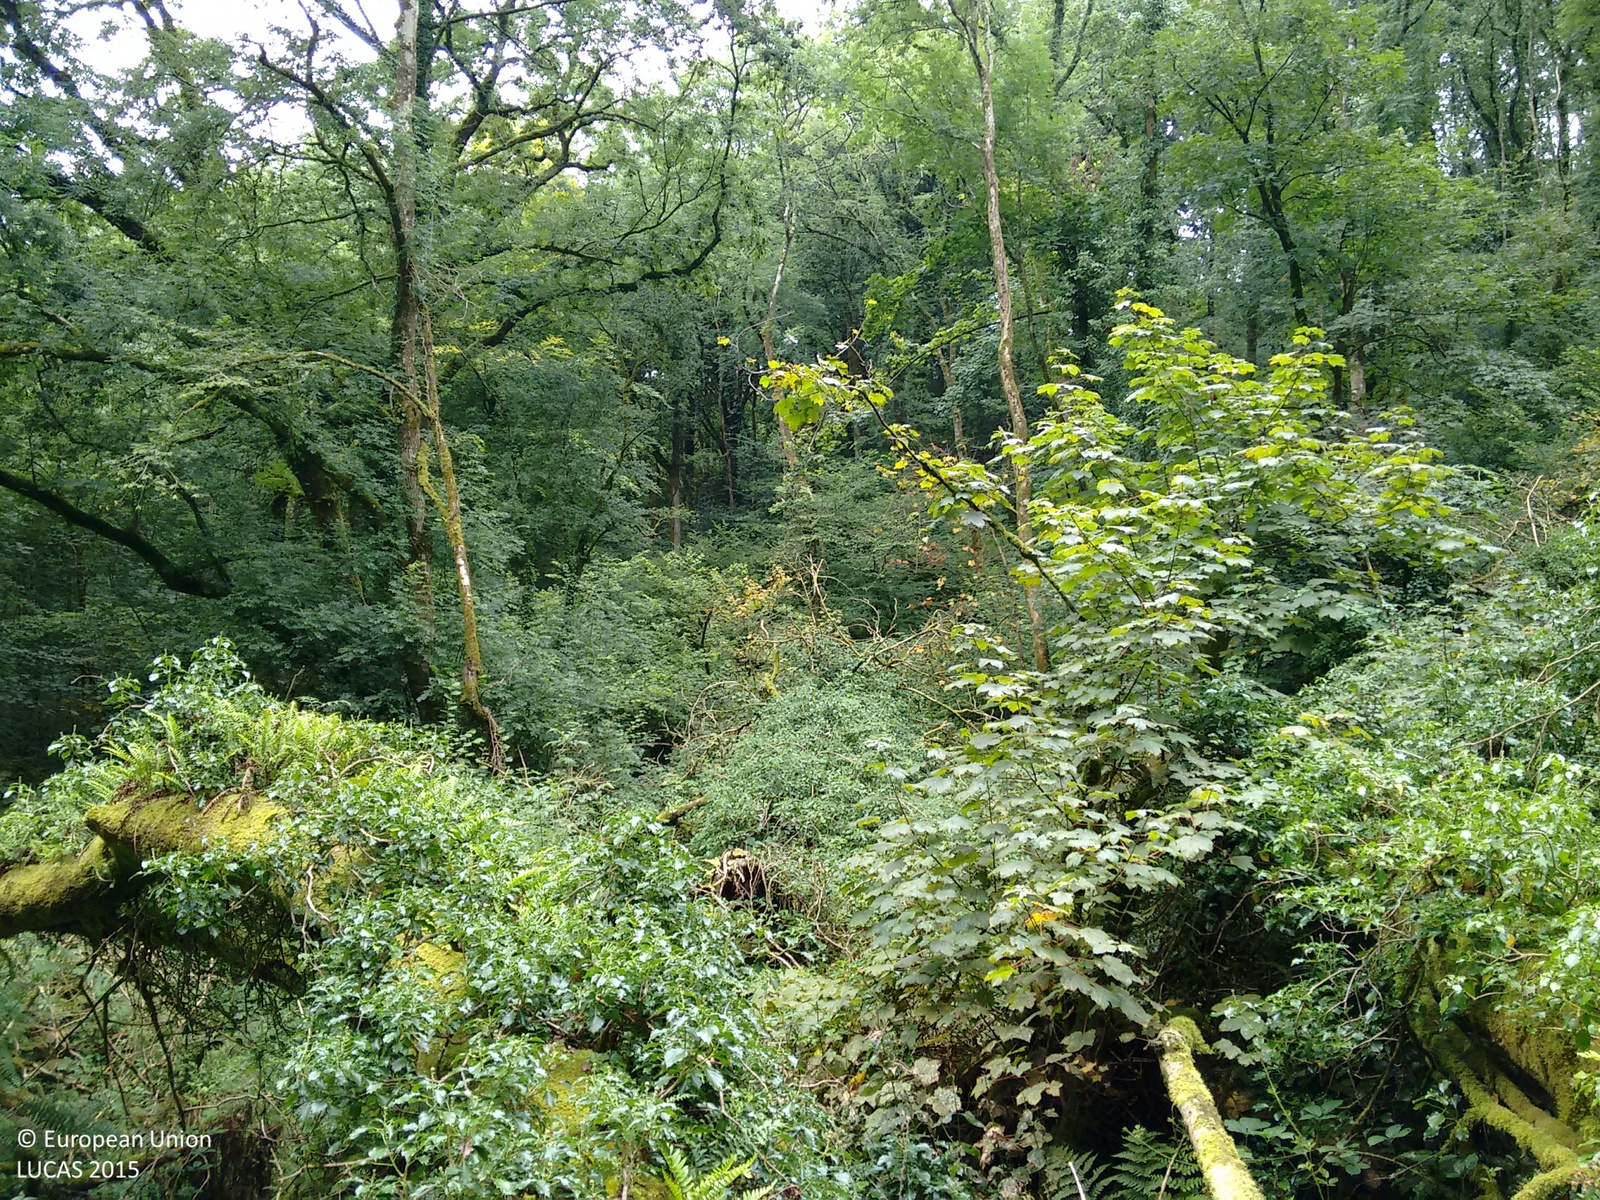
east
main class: Woodland
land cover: Broadleaved woodland
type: mesophytic deciduous forest
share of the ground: > 75 %
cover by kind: broadleaved forest trees 60 %, shrubs 40 %
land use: Semi-natural and natural areas not in use
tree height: > 5 m
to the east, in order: Broadleaved woodland; Rivers and streams; Broadleaved woodland; Rivers and streams; Broadleaved woodland; Rivers and streams; Broadleaved woodland
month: August
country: GB
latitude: 51.8259
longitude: -4.6622
